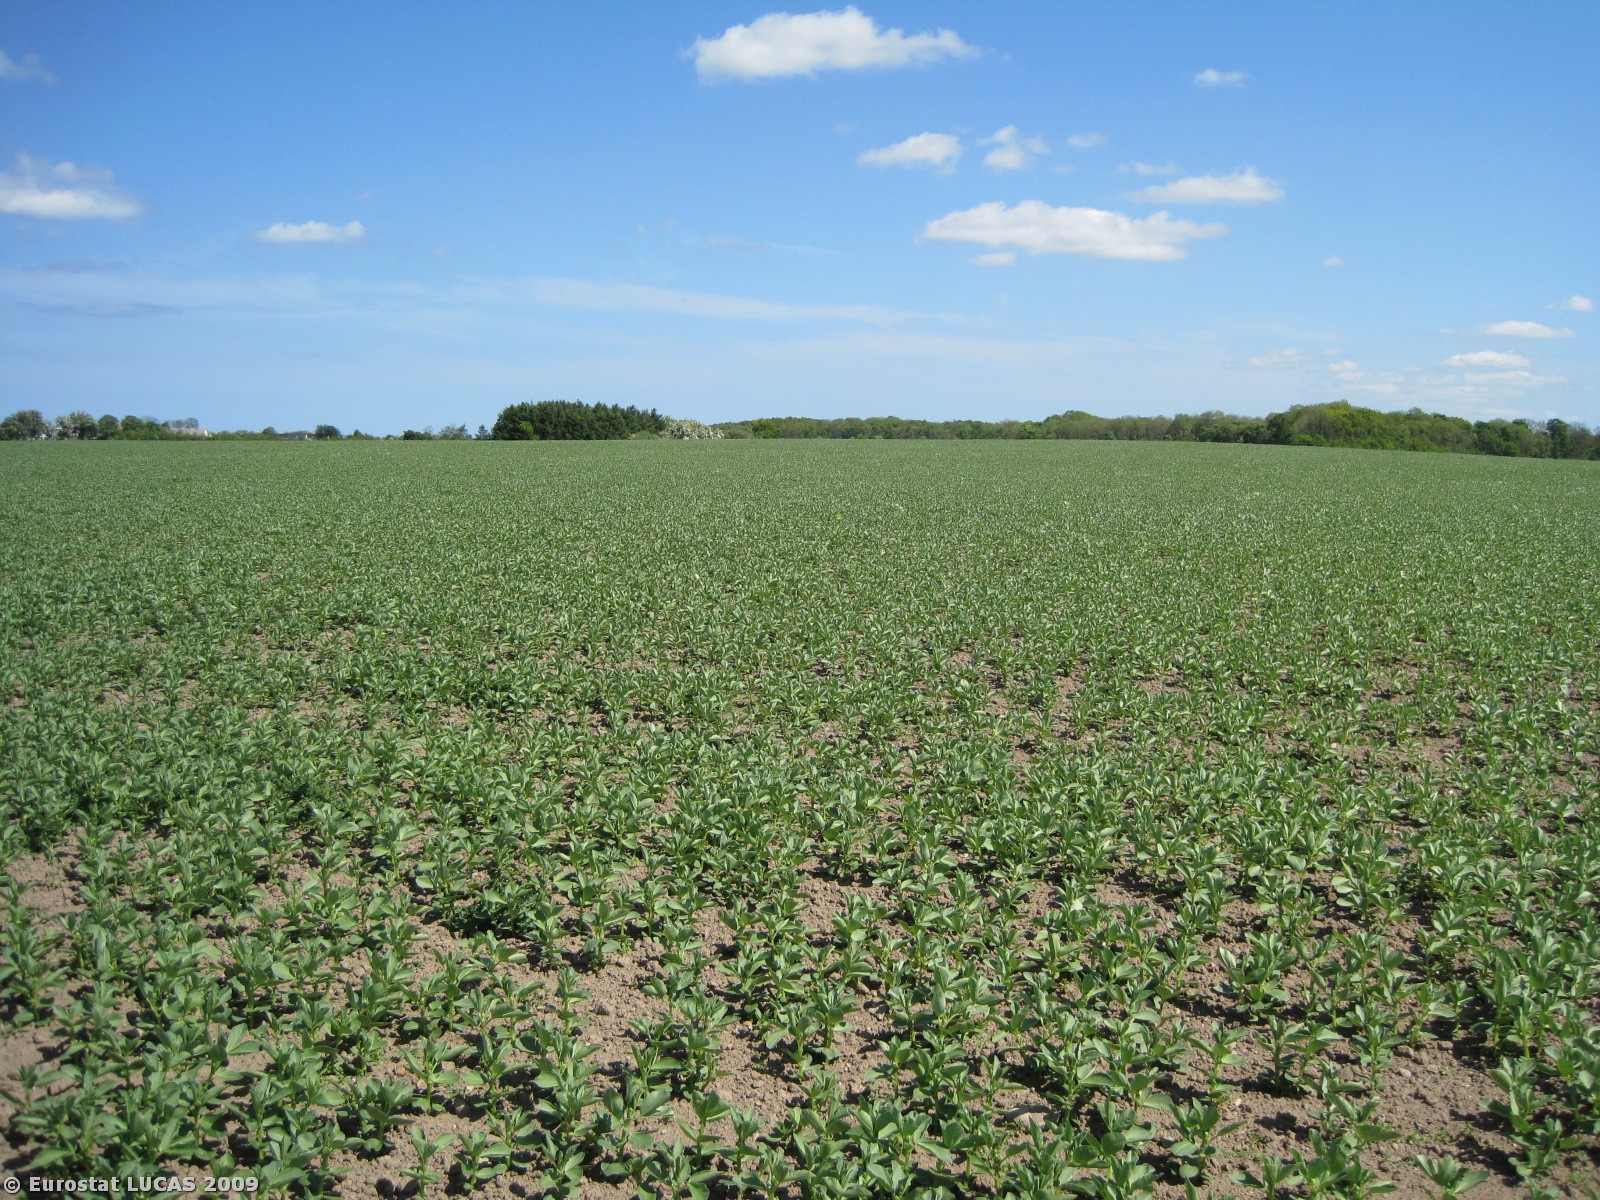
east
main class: Cropland
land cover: Dry pulses
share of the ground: 25 - 50 %
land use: Agriculture (excluding fallow land and kitchen gardens)
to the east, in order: Dry pulses
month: May
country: DK
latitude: 56.5110
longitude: 10.2759
